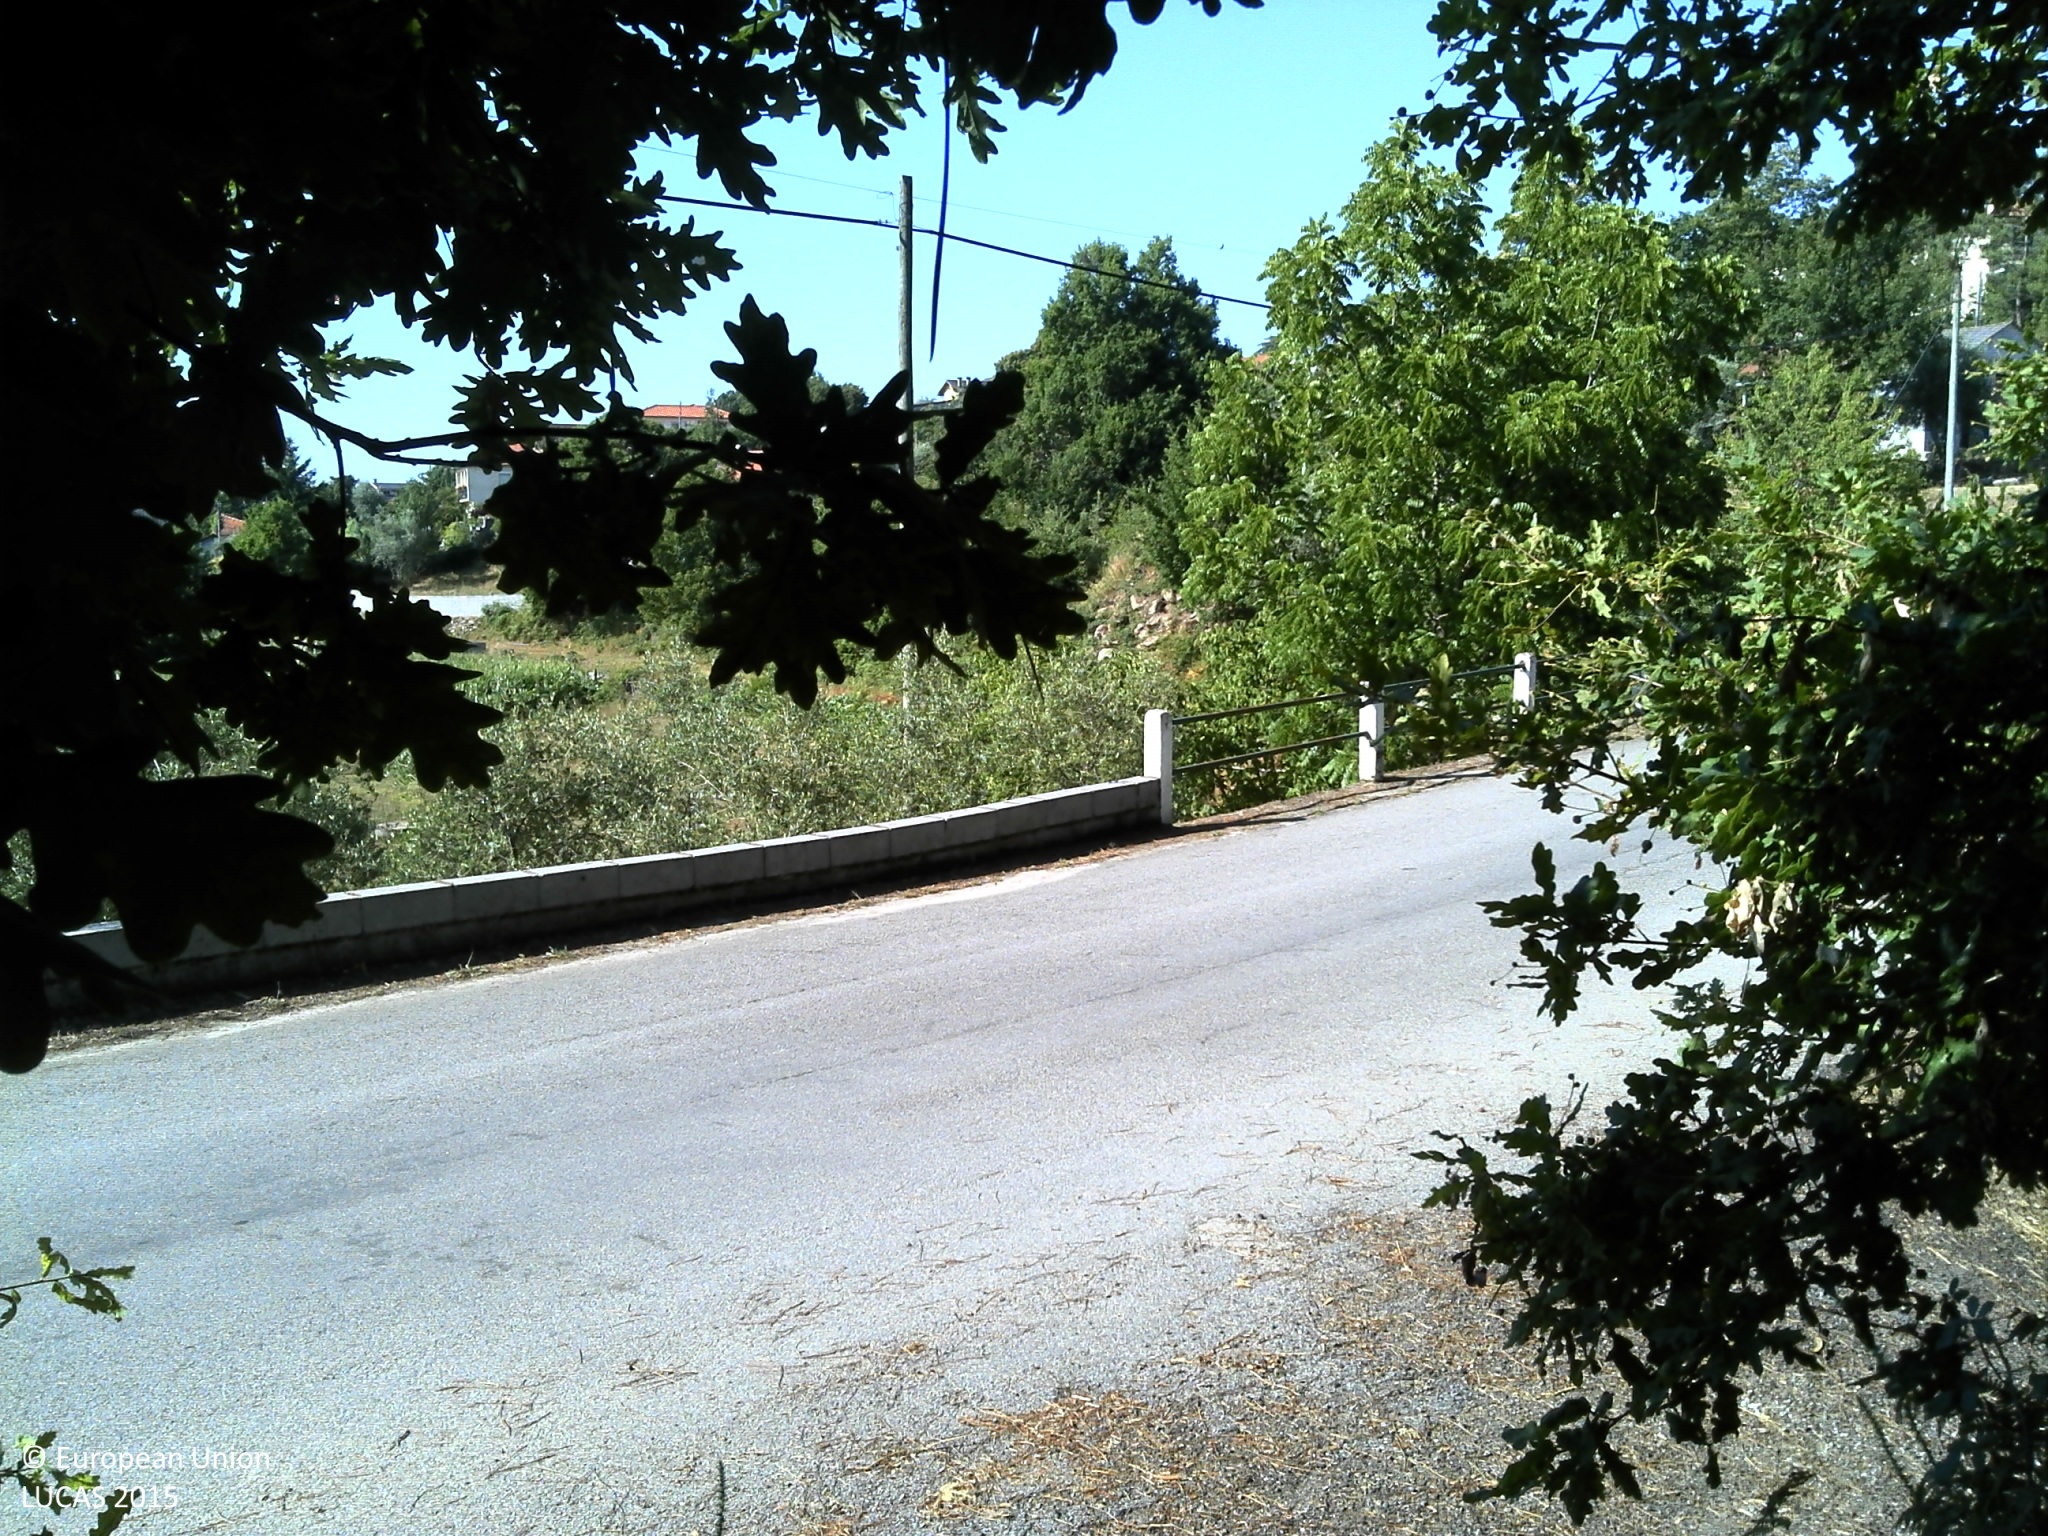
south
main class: Woodland
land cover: Pine dominated mixed woodland
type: coniferous forest of the mediterranean region
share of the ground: 10 - 25 %
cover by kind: shrubs 80 %, coniferous forest trees 15 %, broadleaved forest trees 5 %
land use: Forestry
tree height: > 5 m
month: July
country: PT
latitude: 40.8001
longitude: -7.8205
